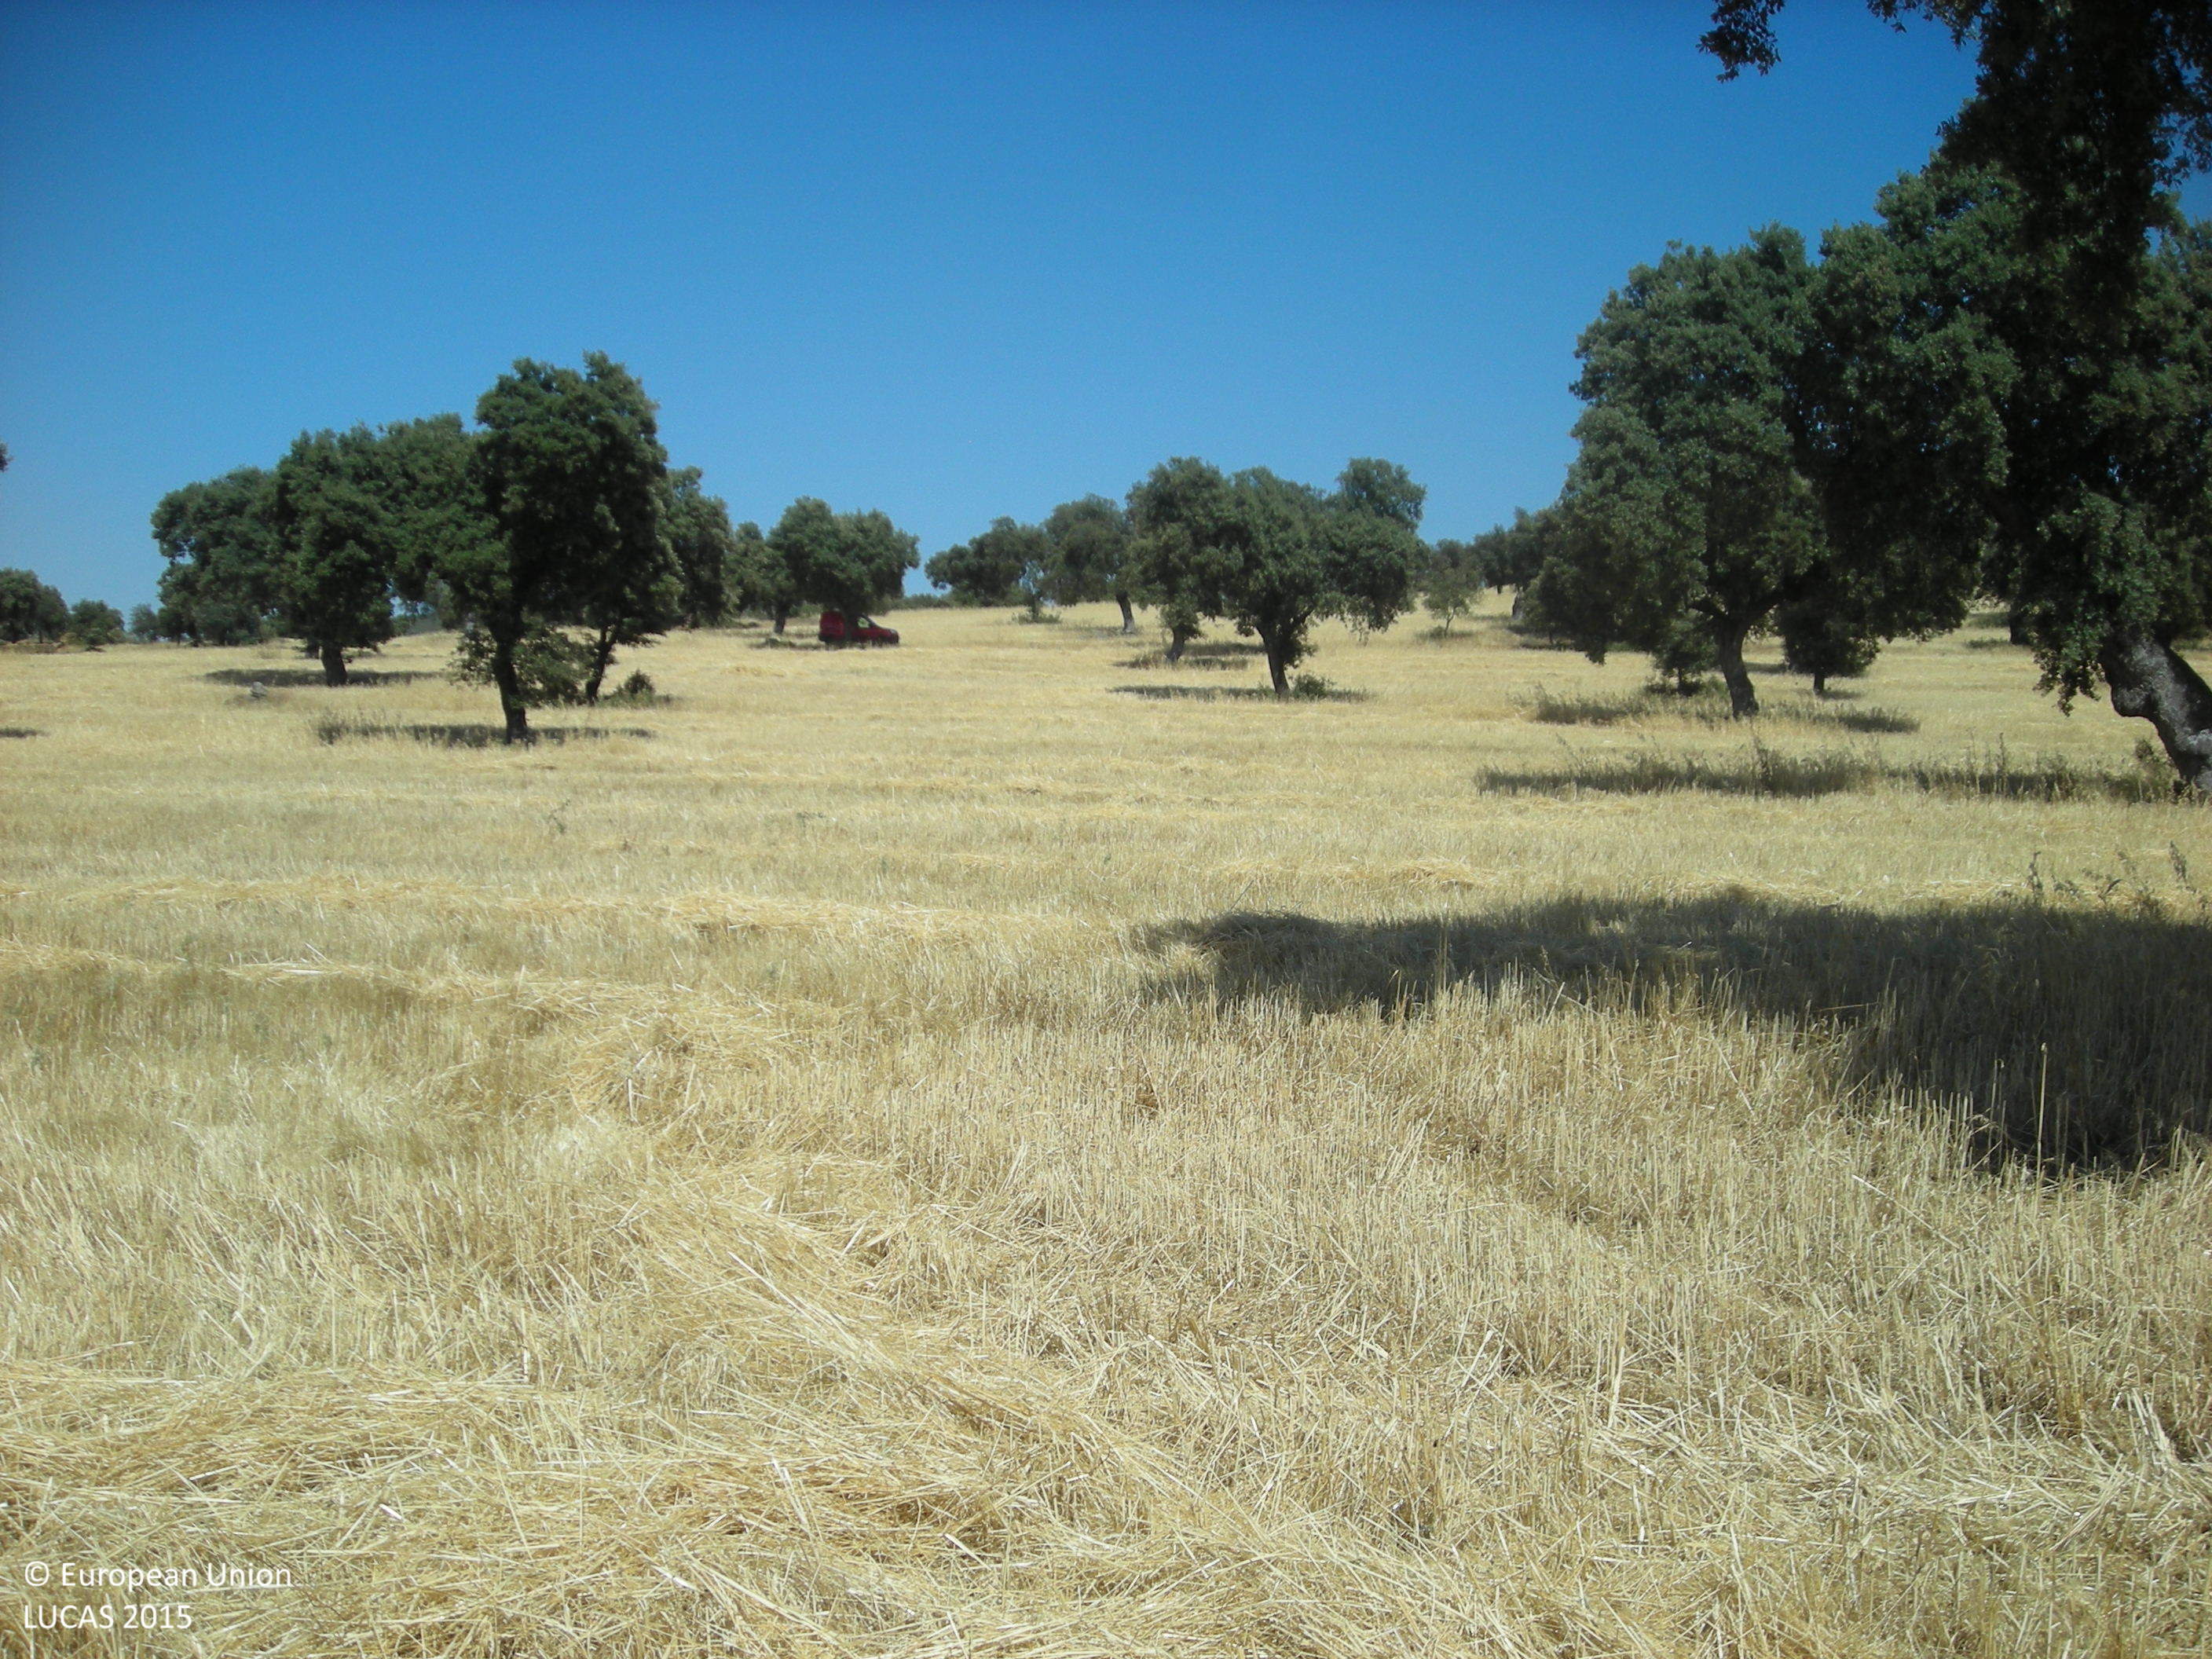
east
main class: Cropland
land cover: Mixed cereals for fodder
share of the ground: > 75 %
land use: Agriculture (excluding fallow land and kitchen gardens)
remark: Harvested field
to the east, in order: Mixed cereals for fodder; Tracks; Mixed cereals for fodder; Single bushes/trees; Mixed cereals for fodder; Single bushes/trees; Mixed cereals for fodder; Single bushes/trees; Mixed cereals for fodder
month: June
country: ES
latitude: 38.6195
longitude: -5.7421
